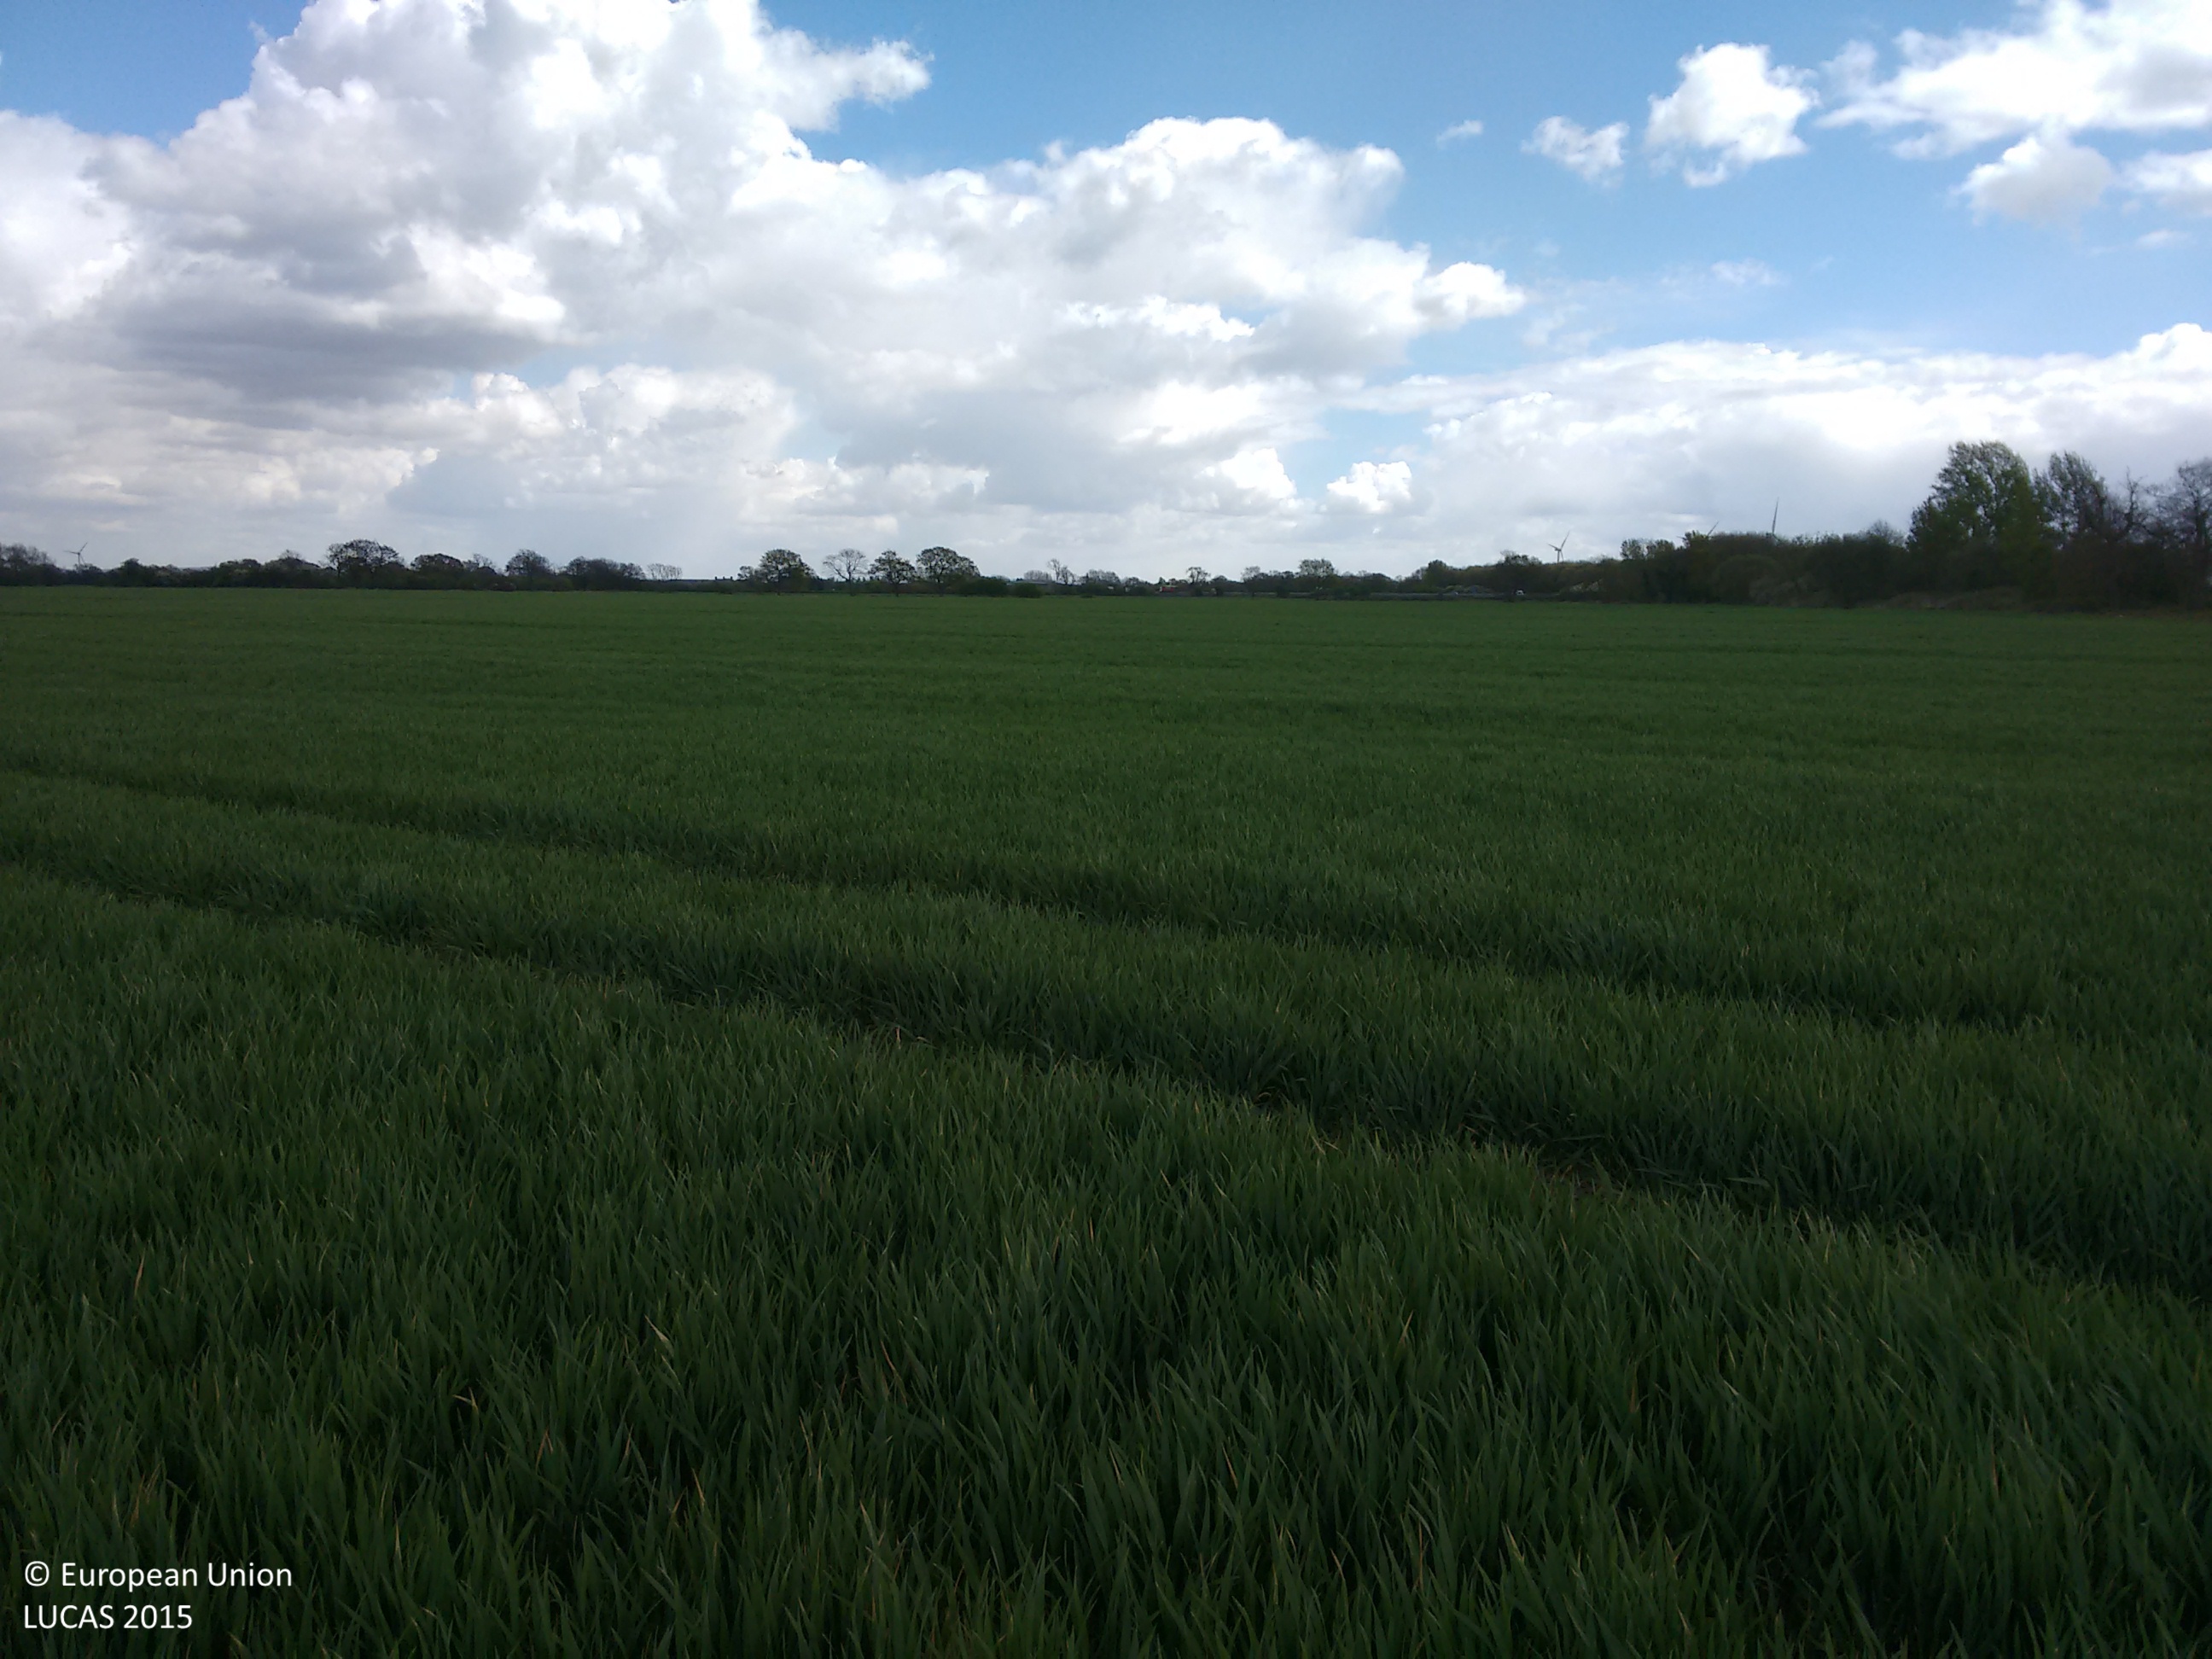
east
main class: Cropland
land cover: Barley
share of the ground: > 75 %
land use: Agriculture (excluding fallow land and kitchen gardens)
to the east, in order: Barley
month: April
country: GB
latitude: 53.7501
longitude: -0.8230
